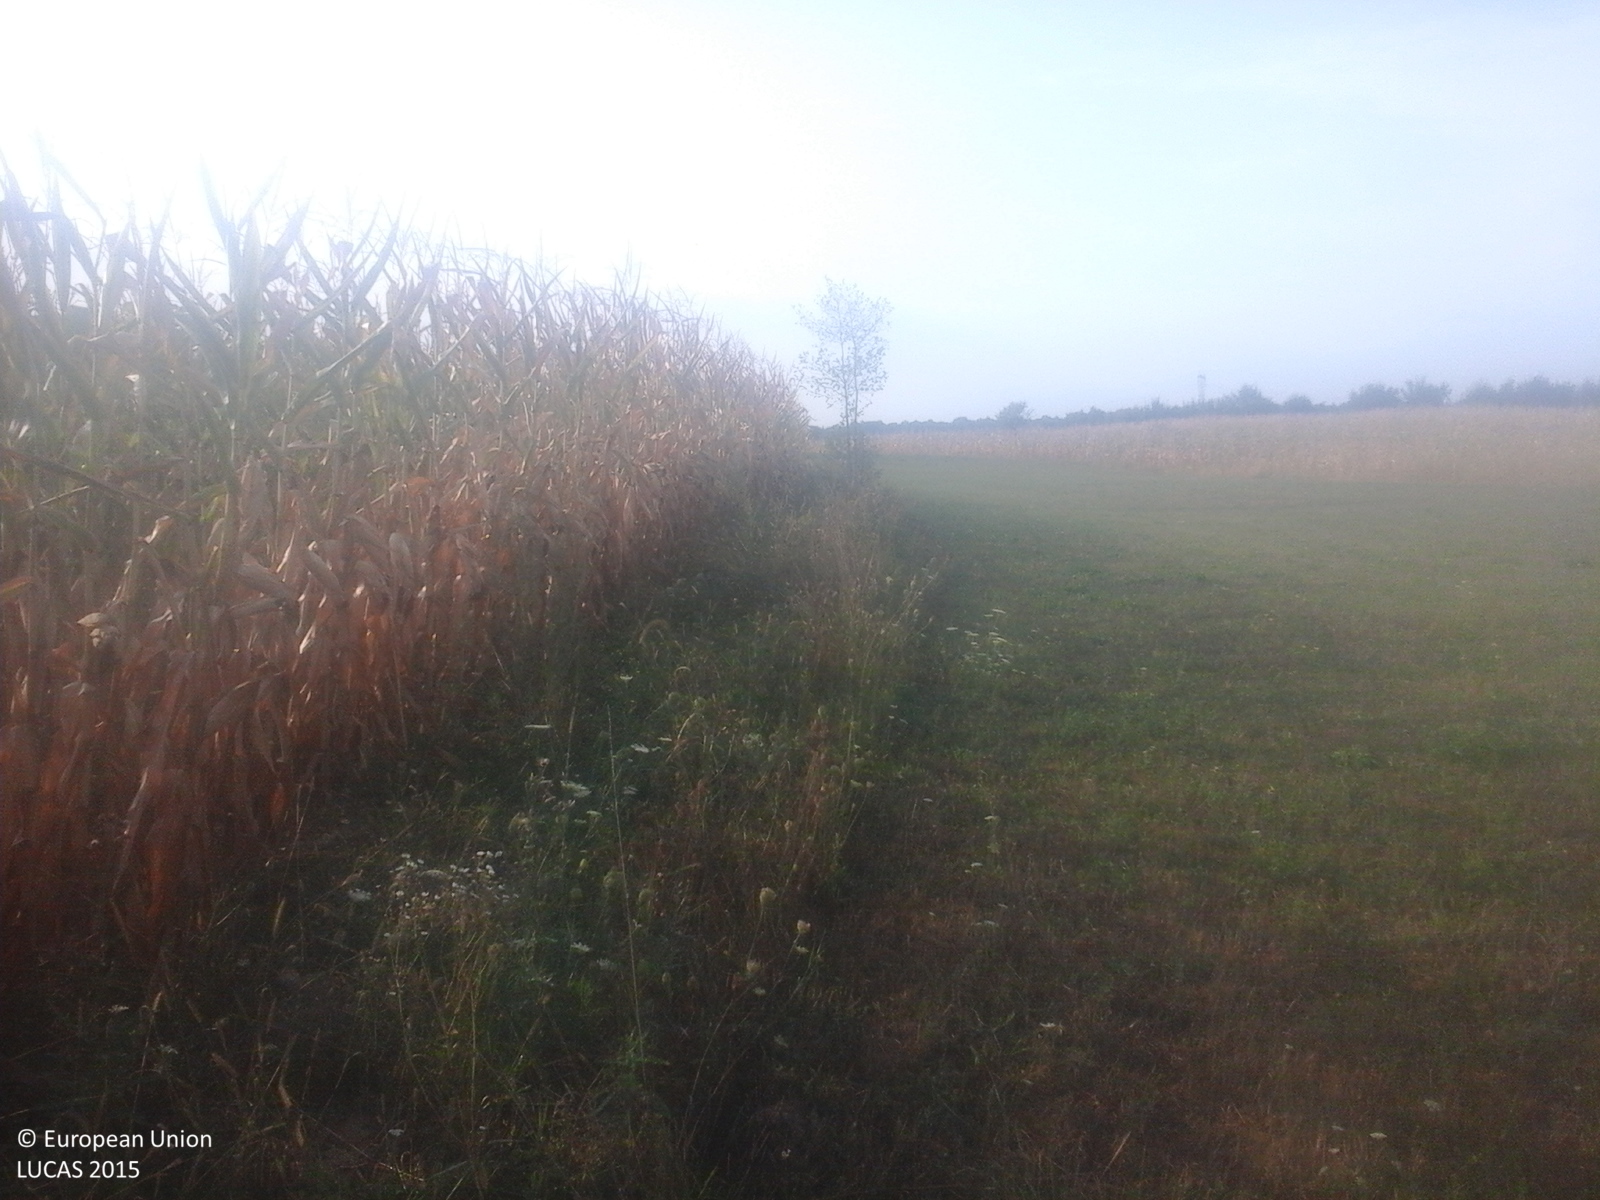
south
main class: Cropland
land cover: Maize
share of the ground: > 75 %
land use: Agriculture (excluding fallow land and kitchen gardens)
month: September
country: RO
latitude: 47.6024
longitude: 23.6848
